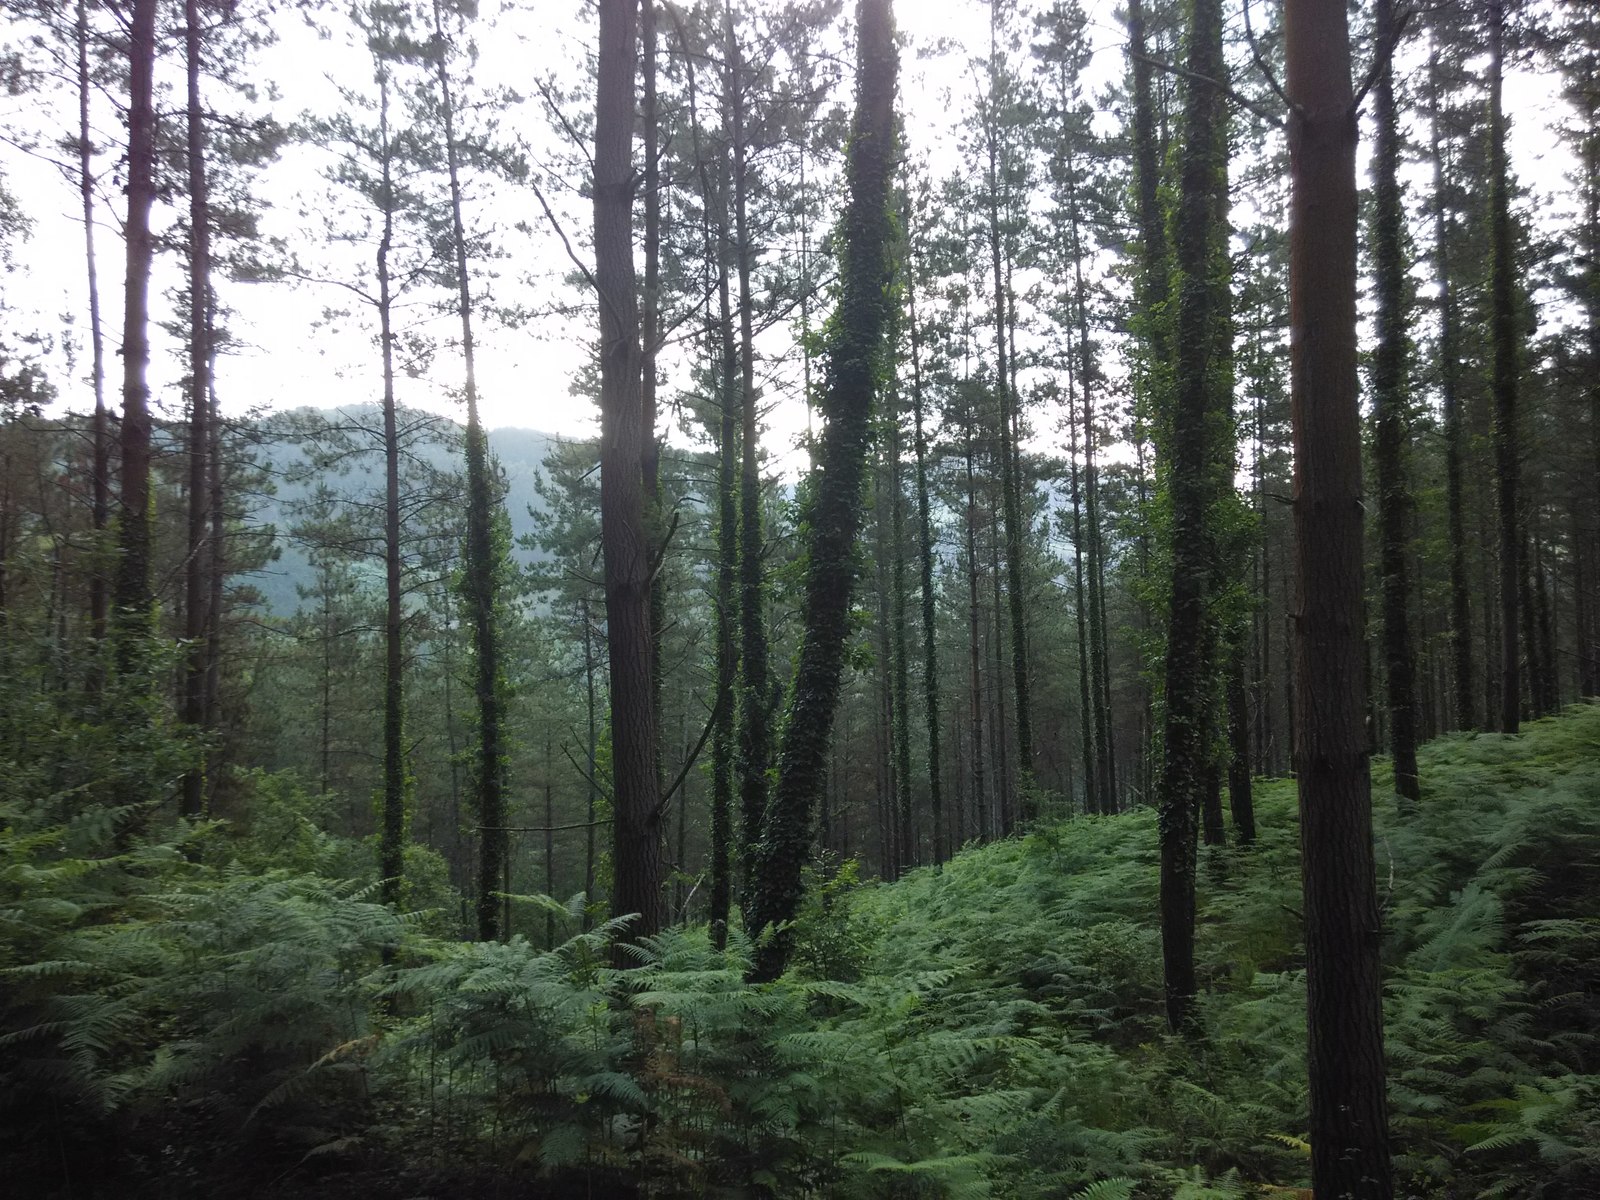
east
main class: Woodland
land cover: Pine dominated coniferous woodland
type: exotic forest
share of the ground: > 75 %
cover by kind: coniferous forest trees 100 %
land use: Forestry
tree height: > 5 m
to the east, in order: Pine dominated coniferous woodland; Tracks; Pine dominated coniferous woodland; Tracks; Pine dominated coniferous woodland; Tracks; Fences; Abandoned hedges; Grassland without tree/shrub cover
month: June
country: ES
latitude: 43.3185
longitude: -2.4950
